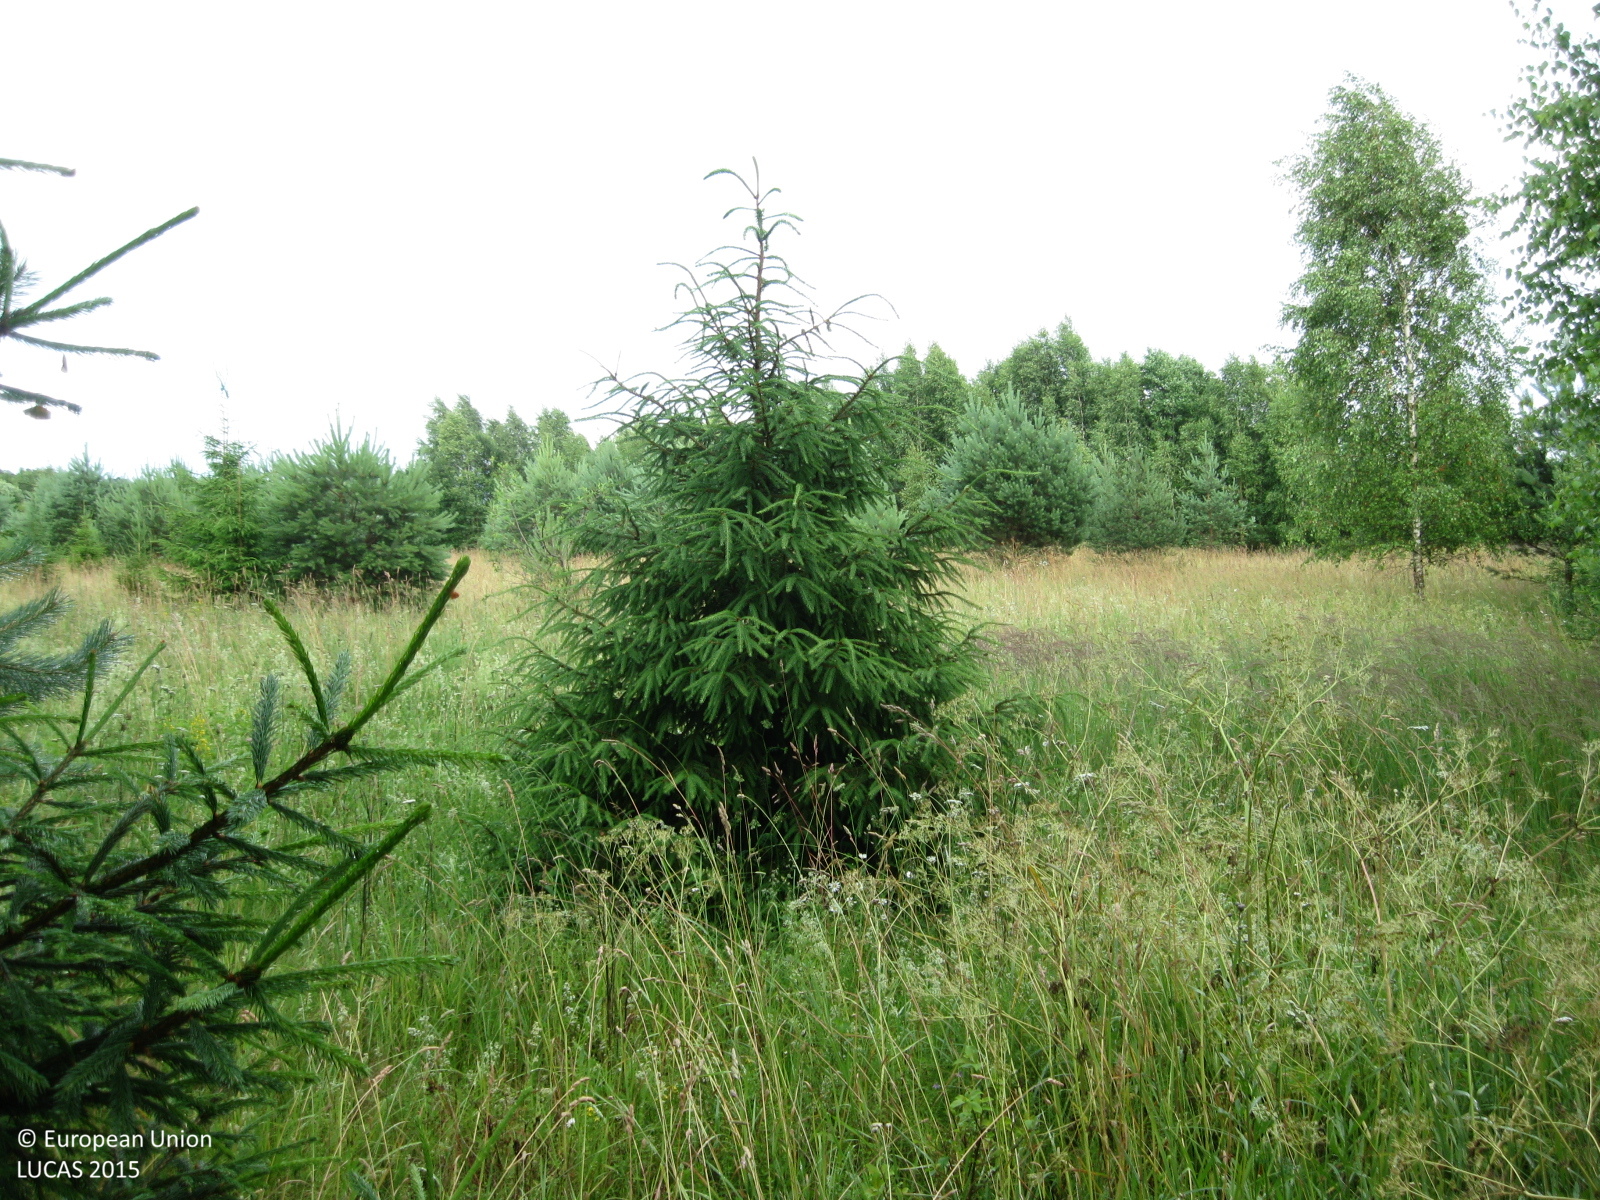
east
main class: Woodland
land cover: Pine dominated mixed woodland
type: hemiboreal forest and nemoral coniferous forest and mixed broadleaved-coniferous forest
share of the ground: 50 - 75 %
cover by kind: herbaceous plants 45 %, coniferous forest trees 35 %, broadleaved forest trees 20 %
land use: Forestry
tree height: > 5 m
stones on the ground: < 10 %
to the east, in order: Pine dominated mixed woodland; Other coniferous woodland; Pine dominated mixed woodland; Spontaneously vegetated surfaces
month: July
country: LT
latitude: 55.7503
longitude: 24.7463
